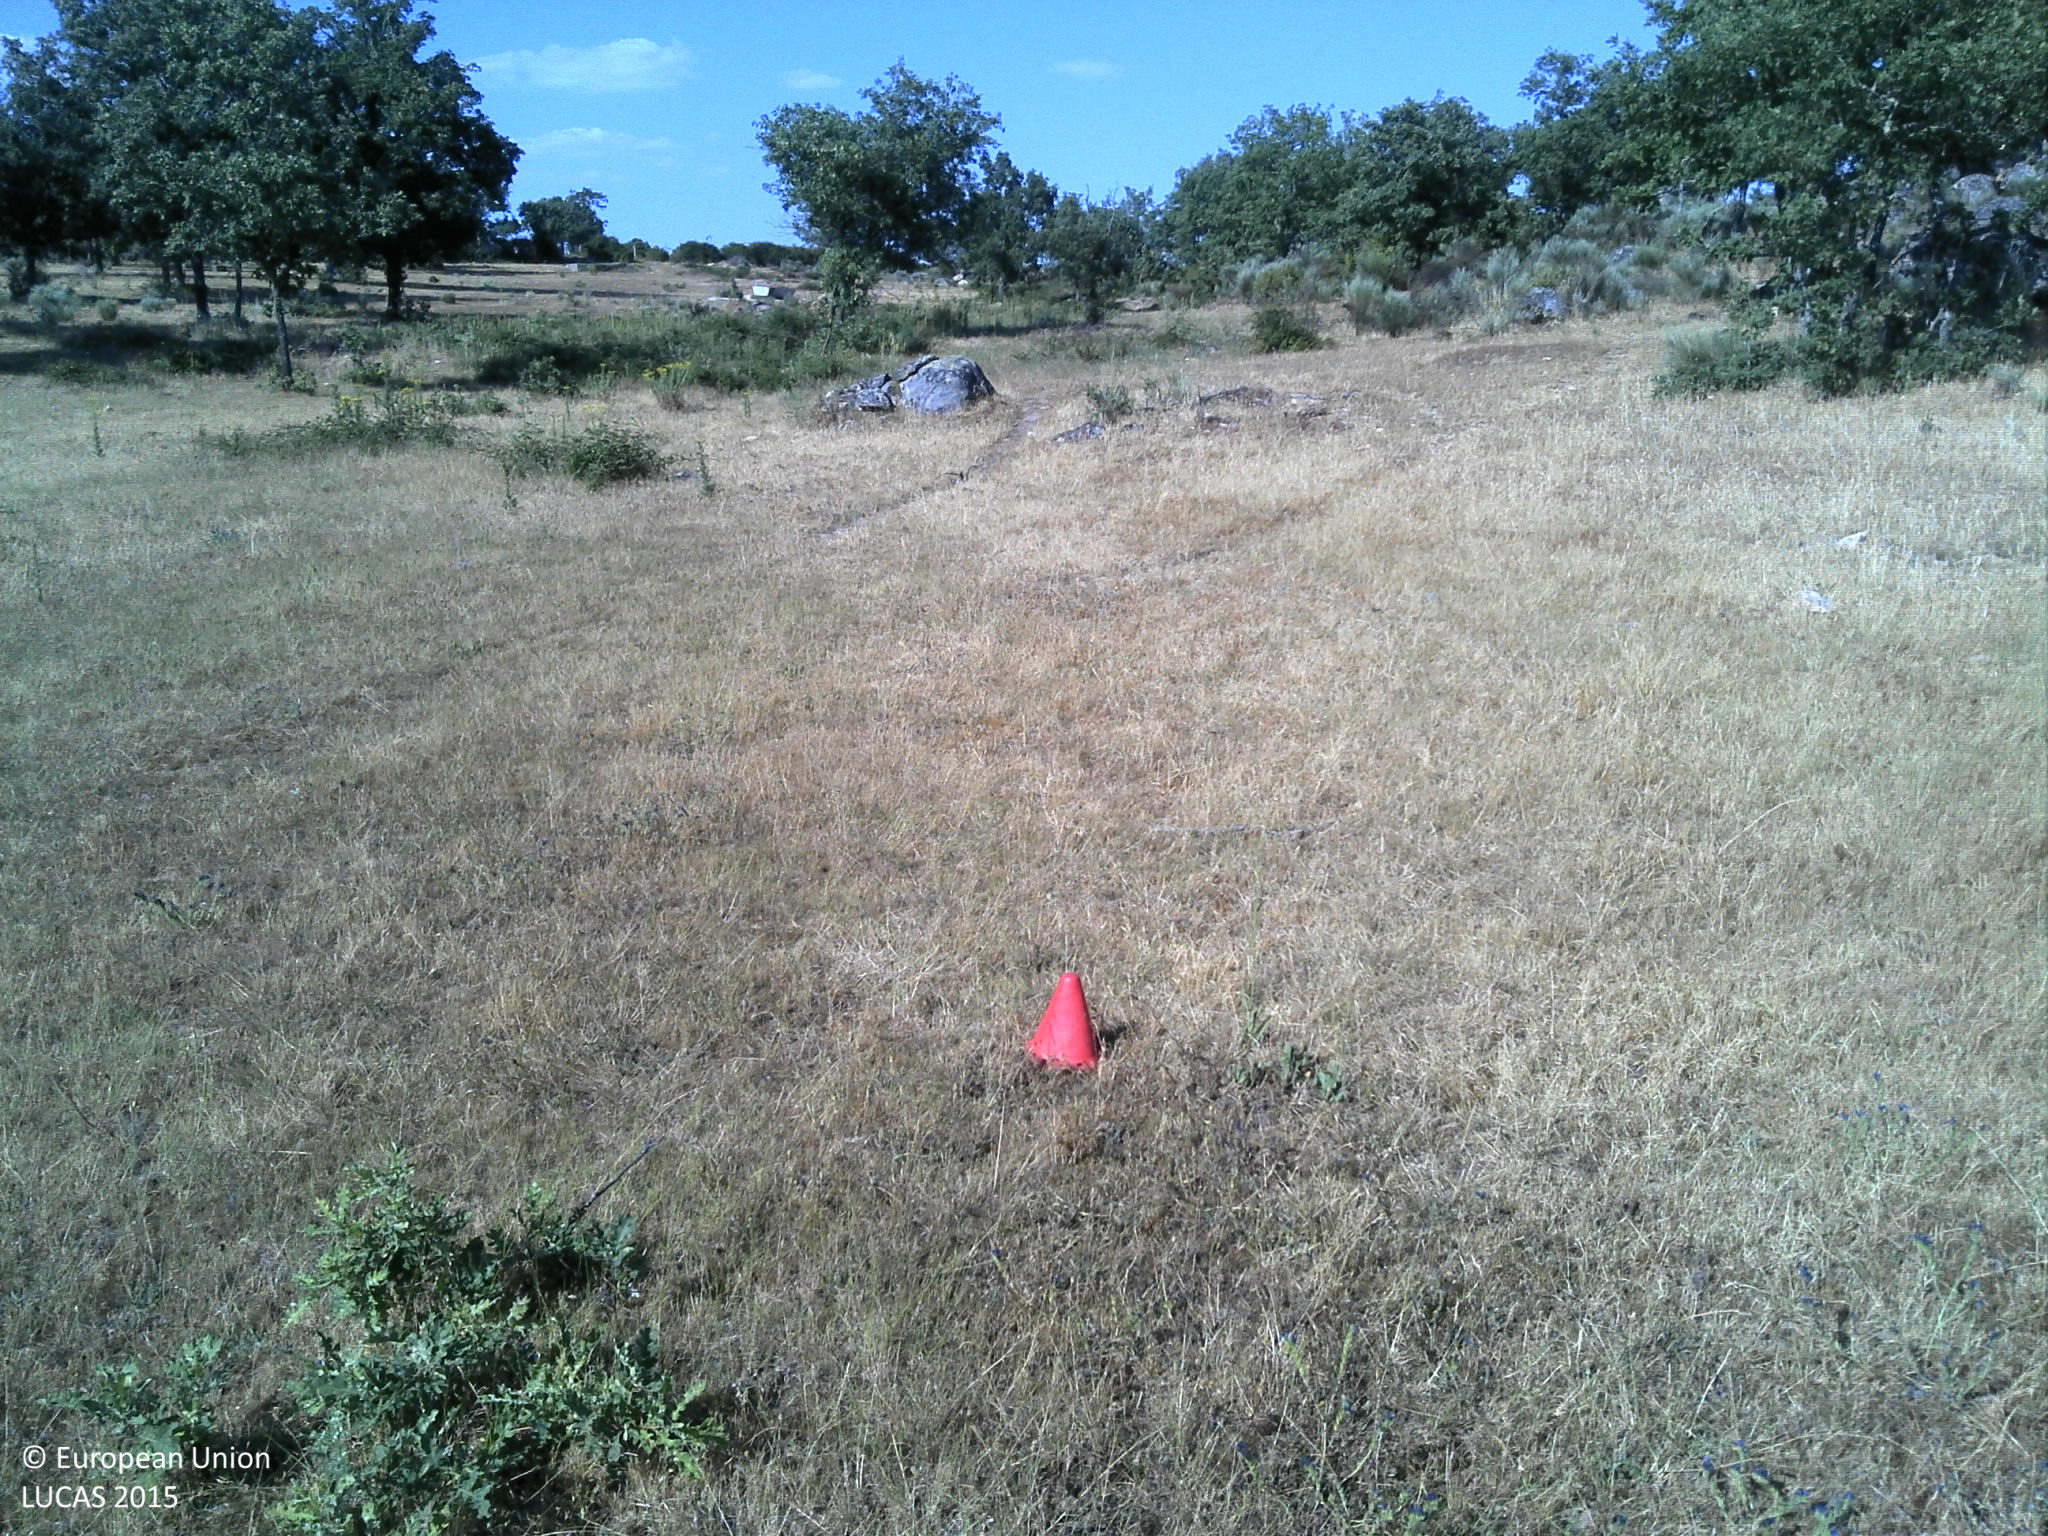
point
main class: Grassland
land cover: Grassland without tree/shrub cover
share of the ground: > 75 %
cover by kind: herbaceous plants 90 %, unconsolidated bare surface 10 %
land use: Agriculture (excluding fallow land and kitchen gardens)
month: June
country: PT
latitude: 40.7893
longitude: -6.8451
